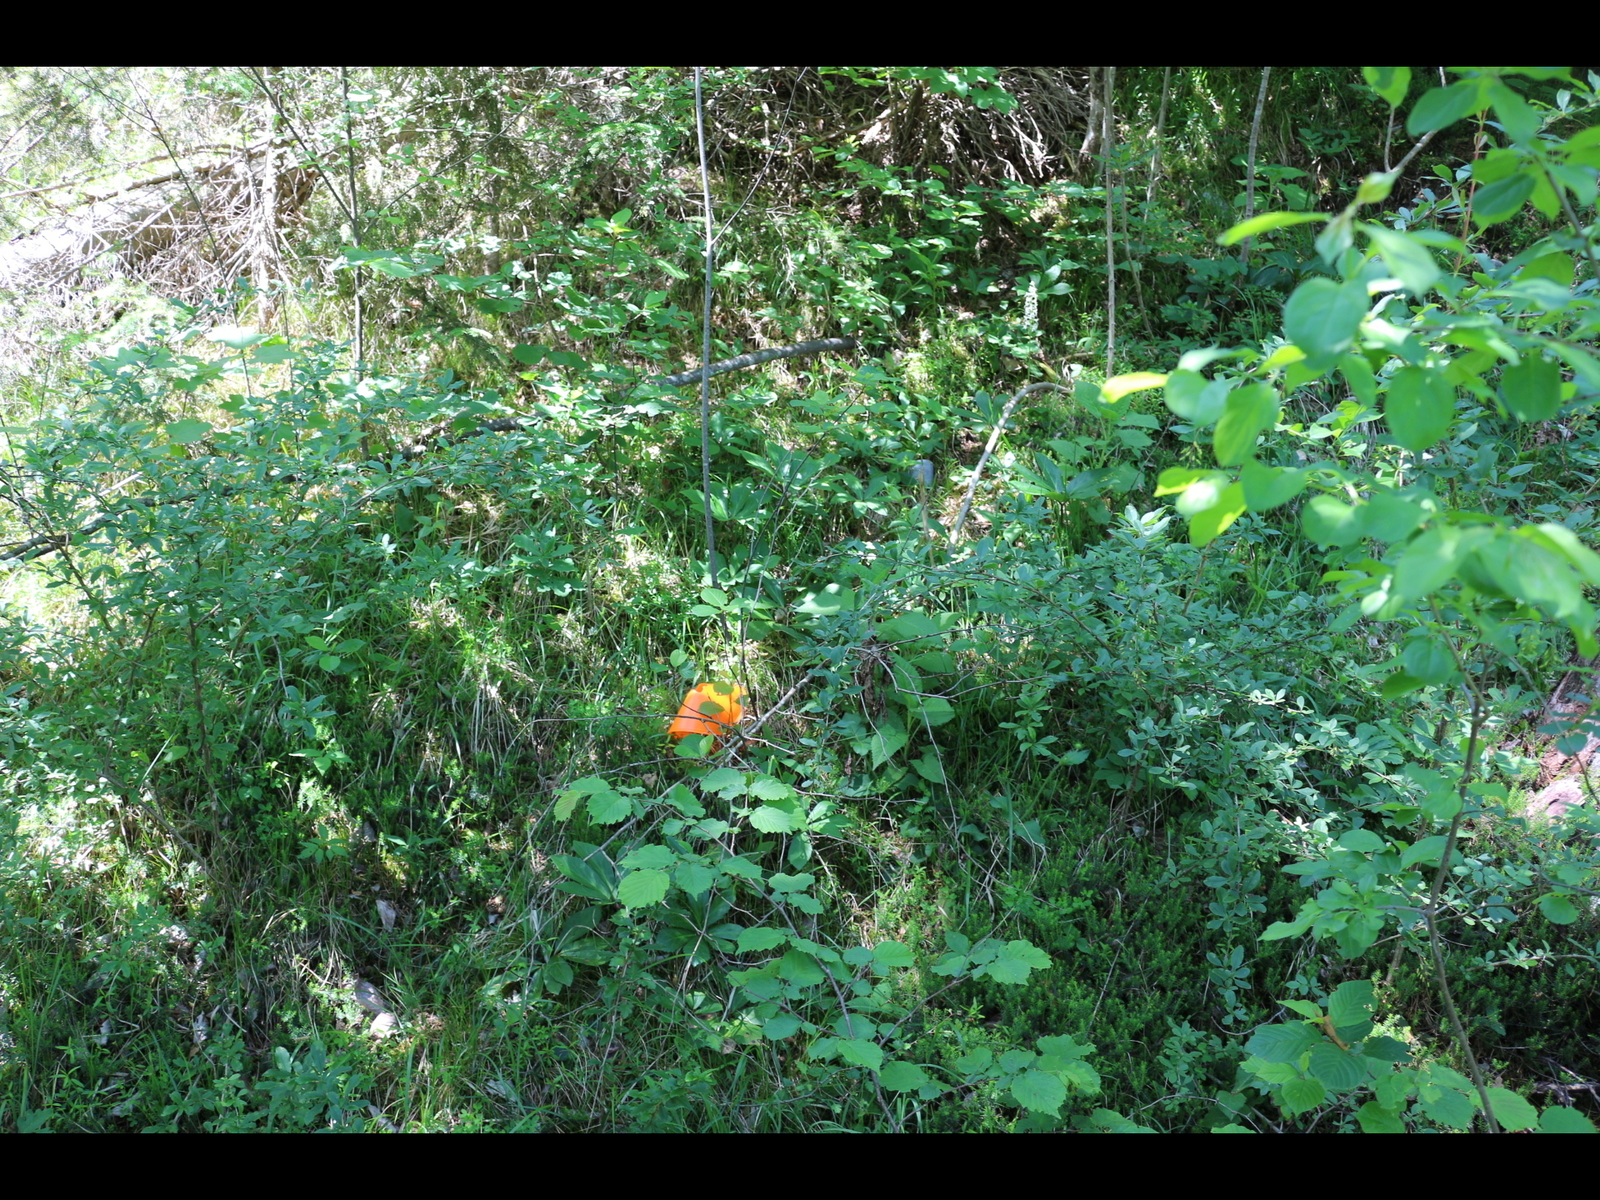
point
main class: Woodland
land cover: Pine dominated mixed woodland
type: alpine coniferous forest
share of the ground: > 75 %
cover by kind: coniferous forest trees 60 %, broadleaved forest trees 35 %, shrubs 5 %
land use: Forestry
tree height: > 5 m
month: May
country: AT
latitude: 46.5250
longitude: 14.1036
